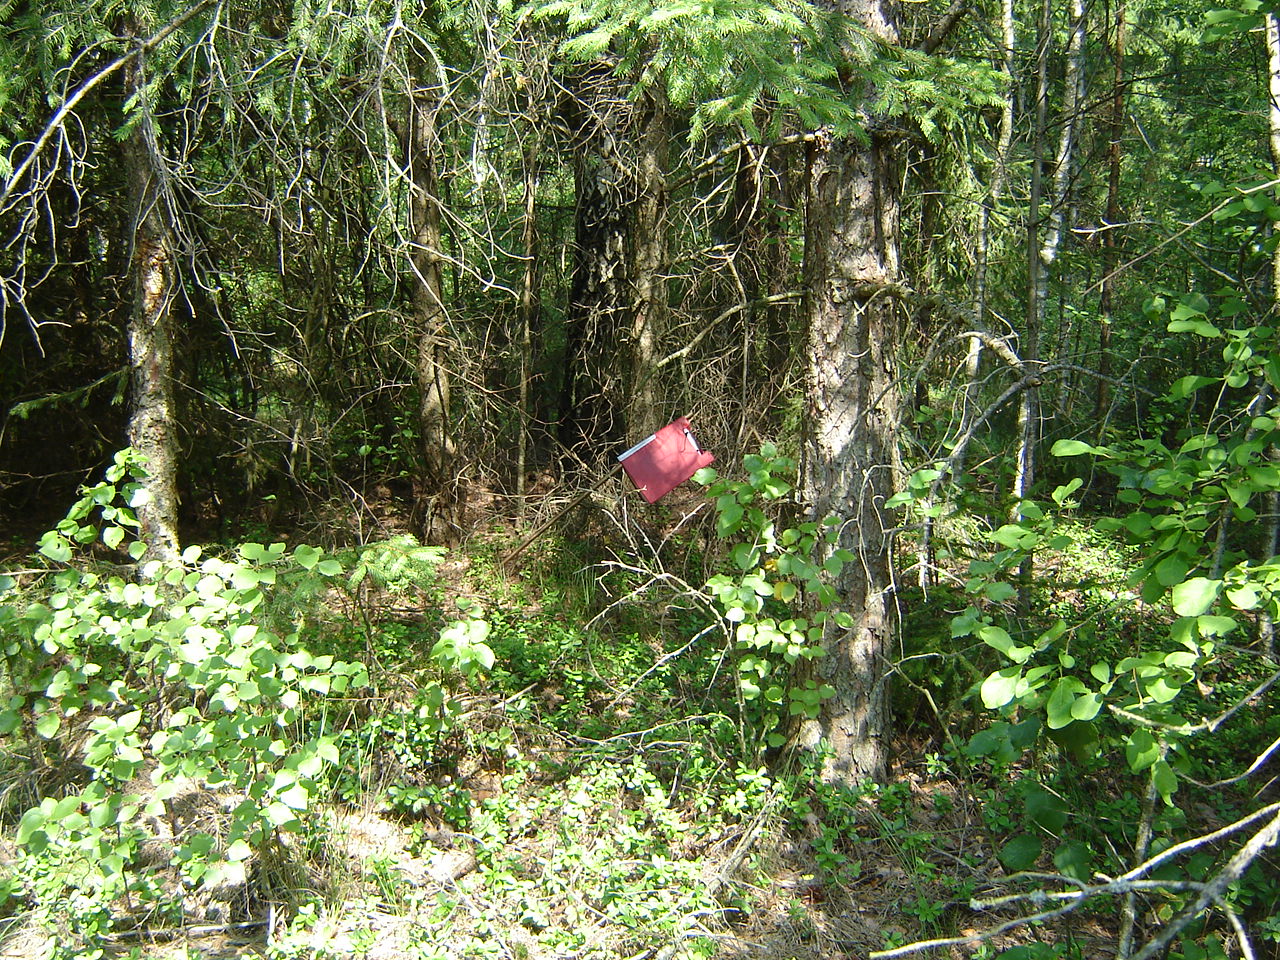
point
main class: Woodland
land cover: Other mixed woodland
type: hemiboreal forest and nemoral coniferous forest and mixed broadleaved-coniferous forest
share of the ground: > 75 %
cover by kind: broadleaved forest trees 50 %, coniferous forest trees 45 %, lichens and mosses 5 %
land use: Forestry
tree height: > 5 m
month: August
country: LT
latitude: 55.0538
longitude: 24.9040
